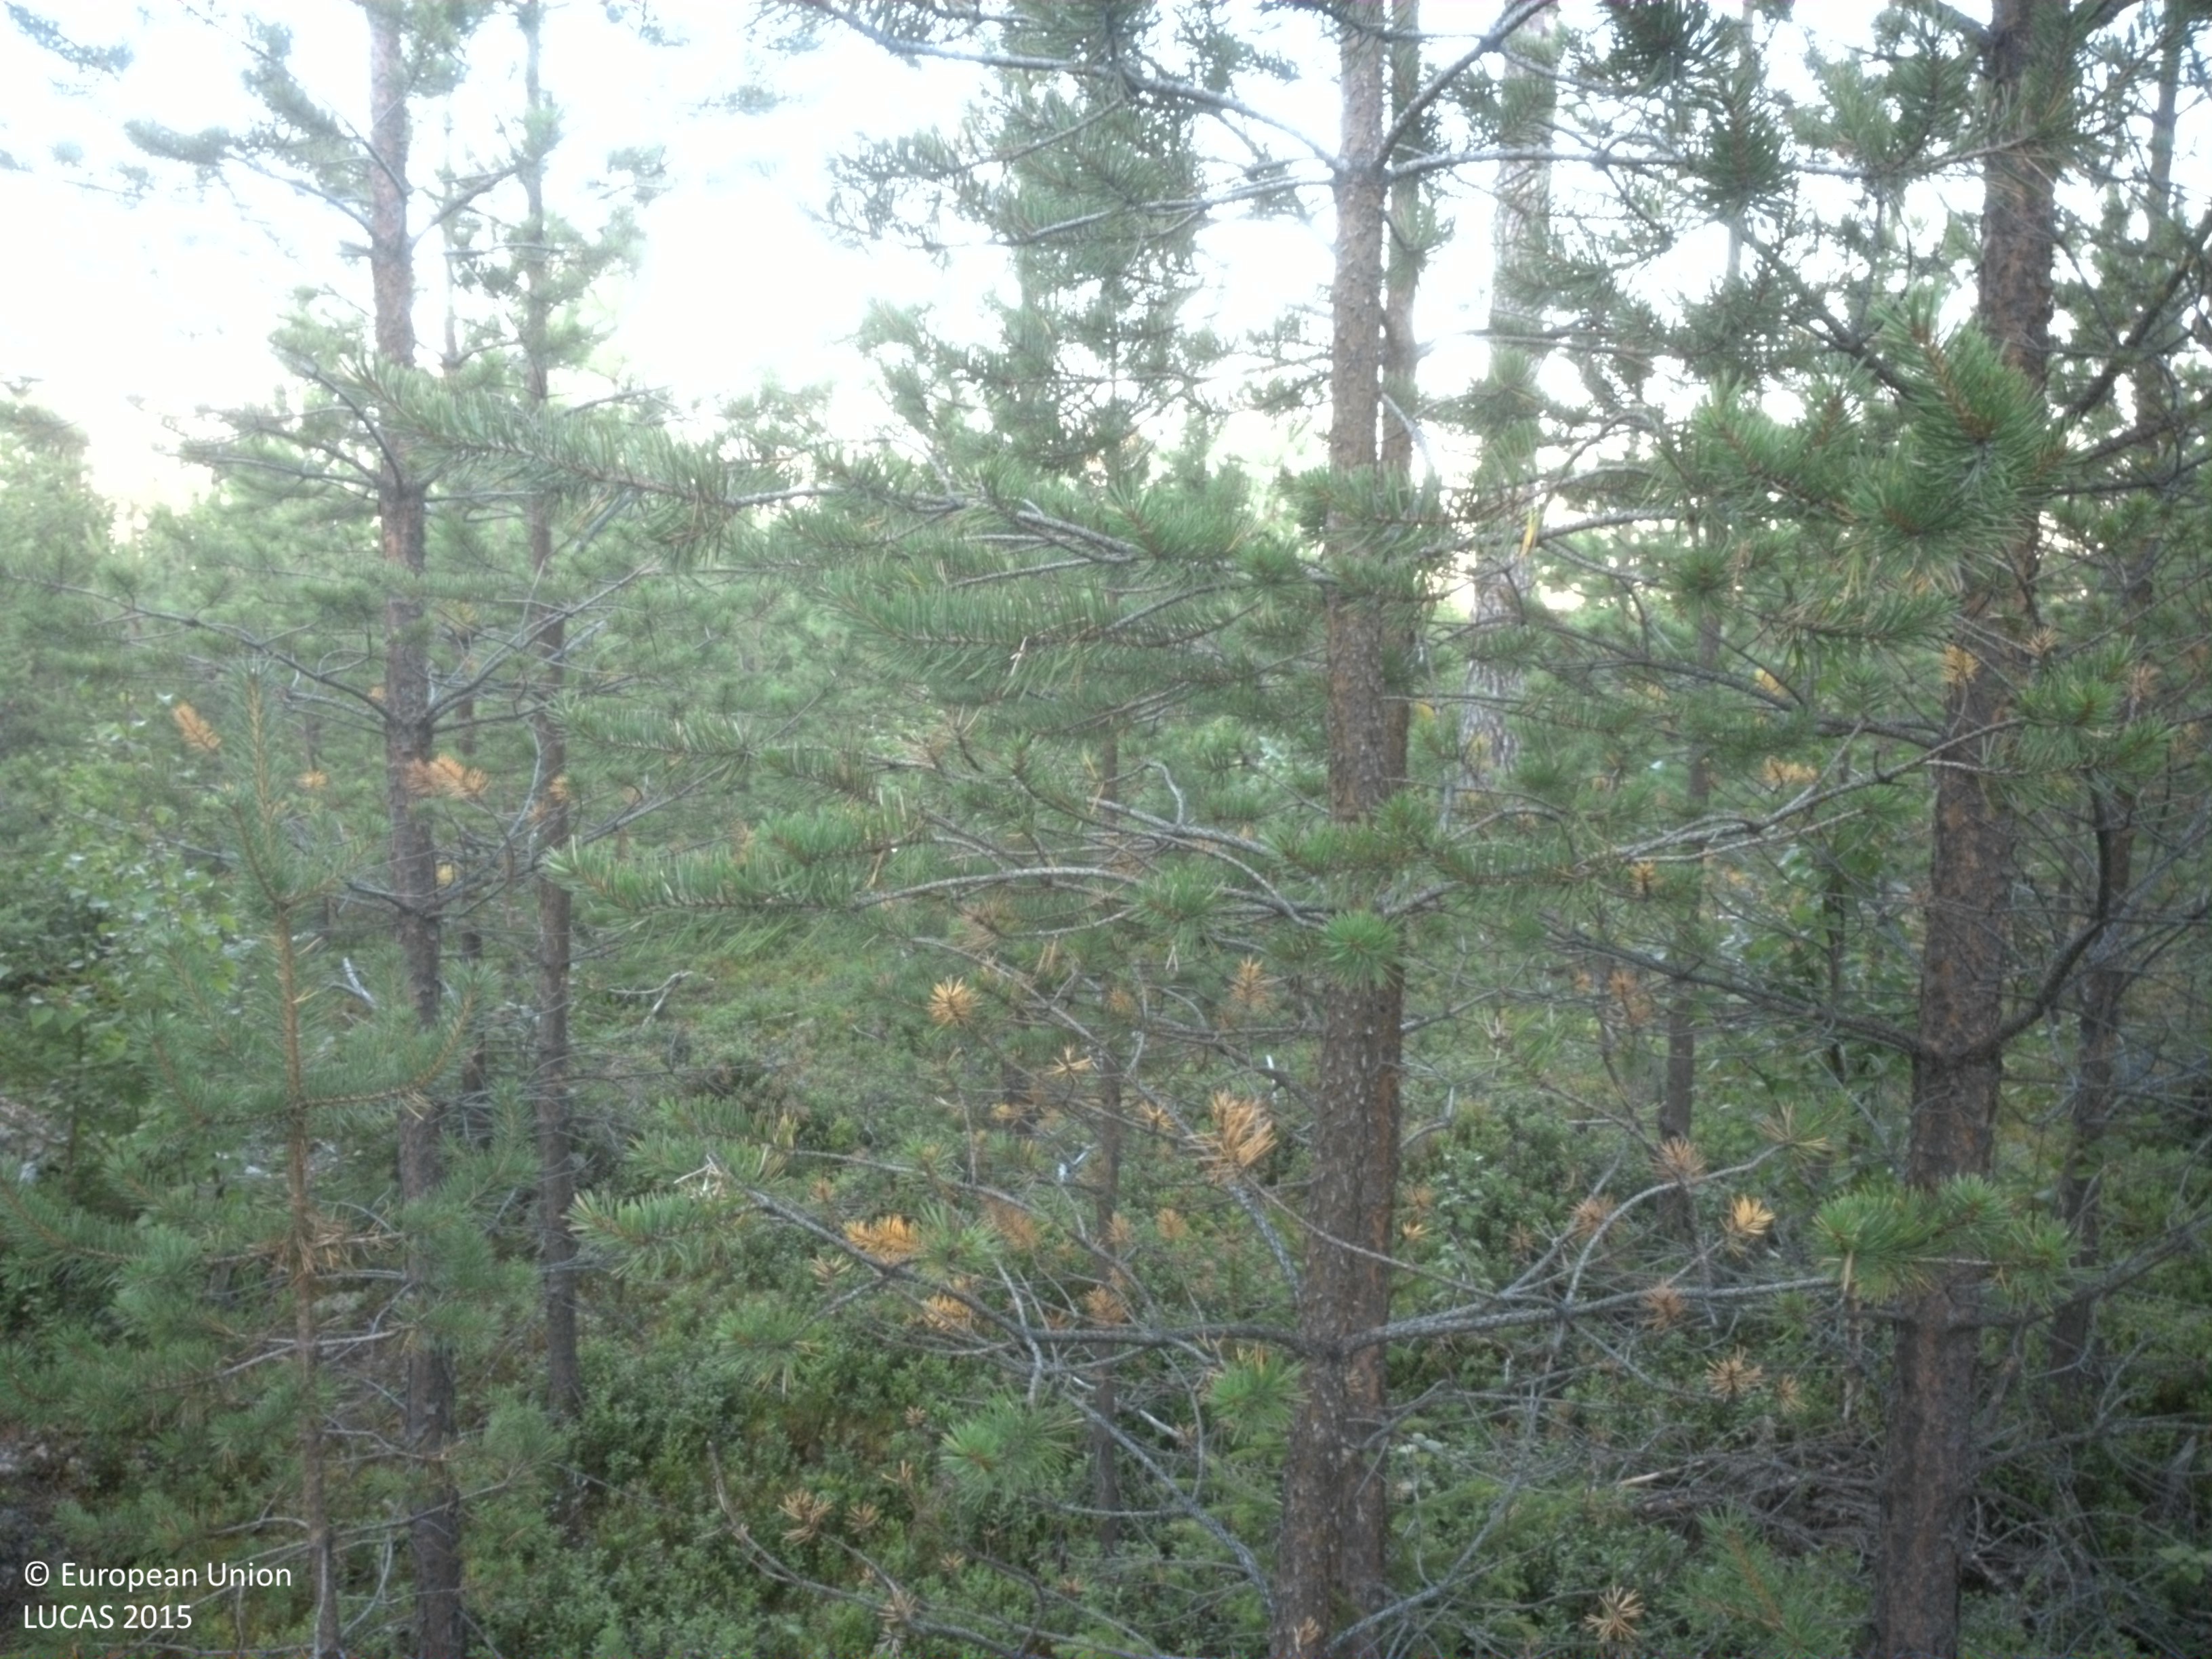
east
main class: Woodland
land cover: Pine dominated coniferous woodland
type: boreal forest
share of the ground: 50 - 75 %
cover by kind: coniferous forest trees 70 %, shrubs 30 %
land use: Forestry
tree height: < 5 m
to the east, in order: Pine dominated coniferous woodland; Pine dominated mixed woodland; Ditches and canals; Paved roads, cycling and walking lanes; Ditches and canals; Shrubland with sparse tree cover; Electric lines; Shrubland with sparse tree cover; Pine dominated mixed woodland; Tracks; Pine dominated mixed woodland; Other mixed woodland
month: August
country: SE
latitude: 64.6391
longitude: 18.9032
